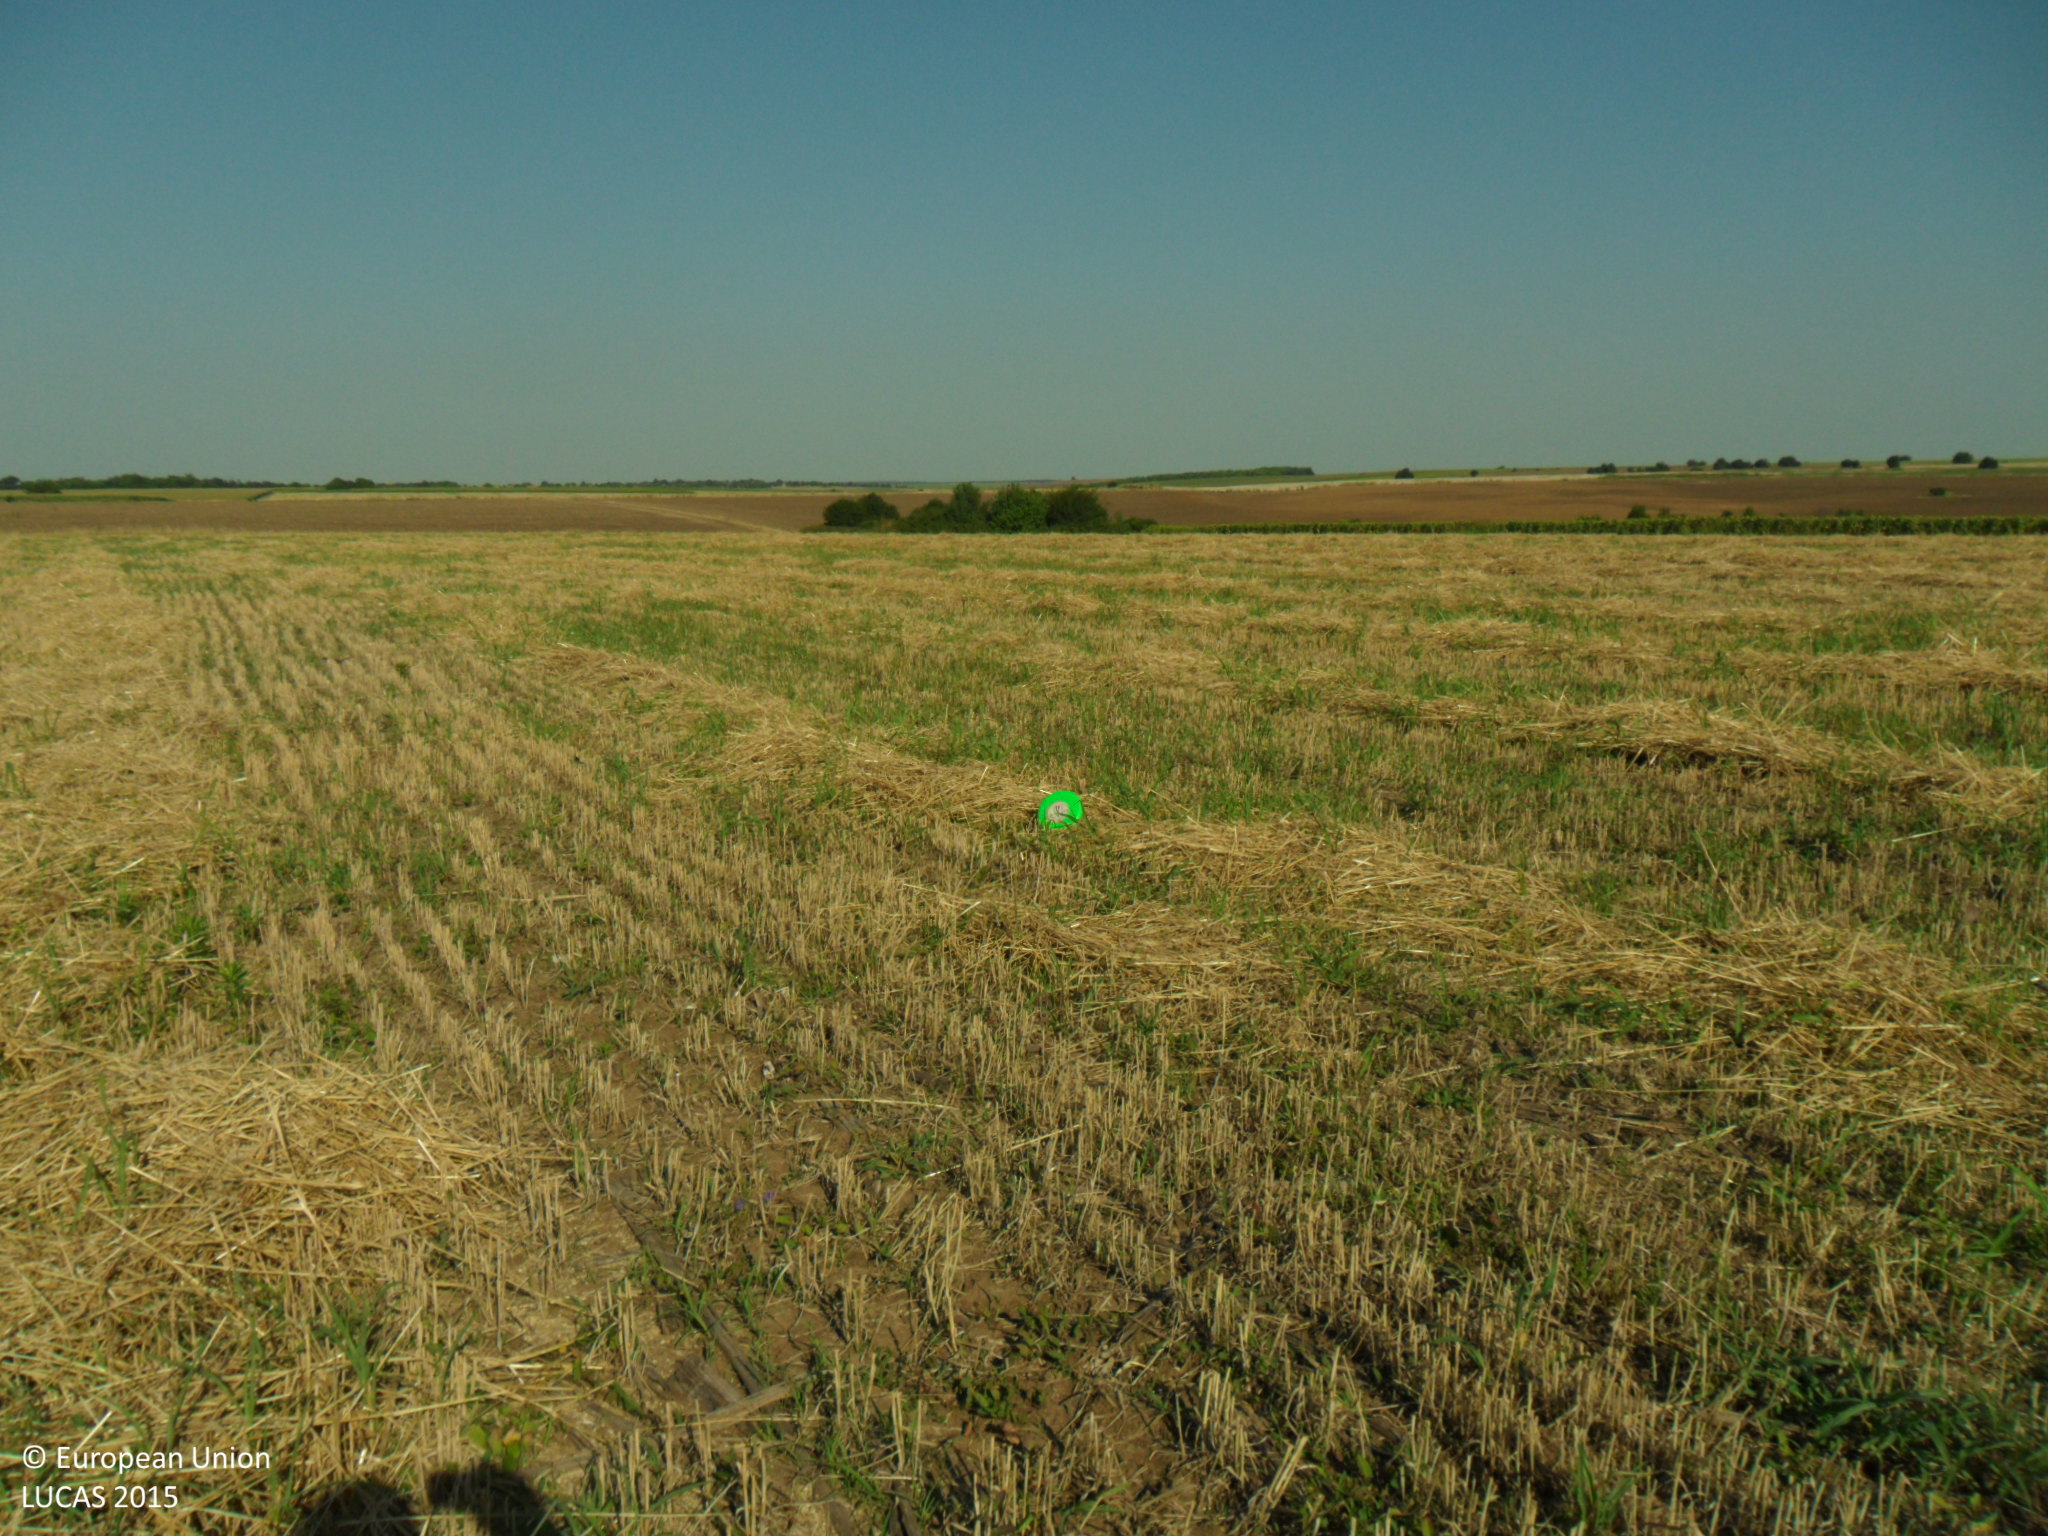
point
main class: Cropland
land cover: Common wheat
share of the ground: 10 - 25 %
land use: Agriculture (excluding fallow land and kitchen gardens)
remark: Harvested field
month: July
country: BG
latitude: 43.8182
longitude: 26.3291
